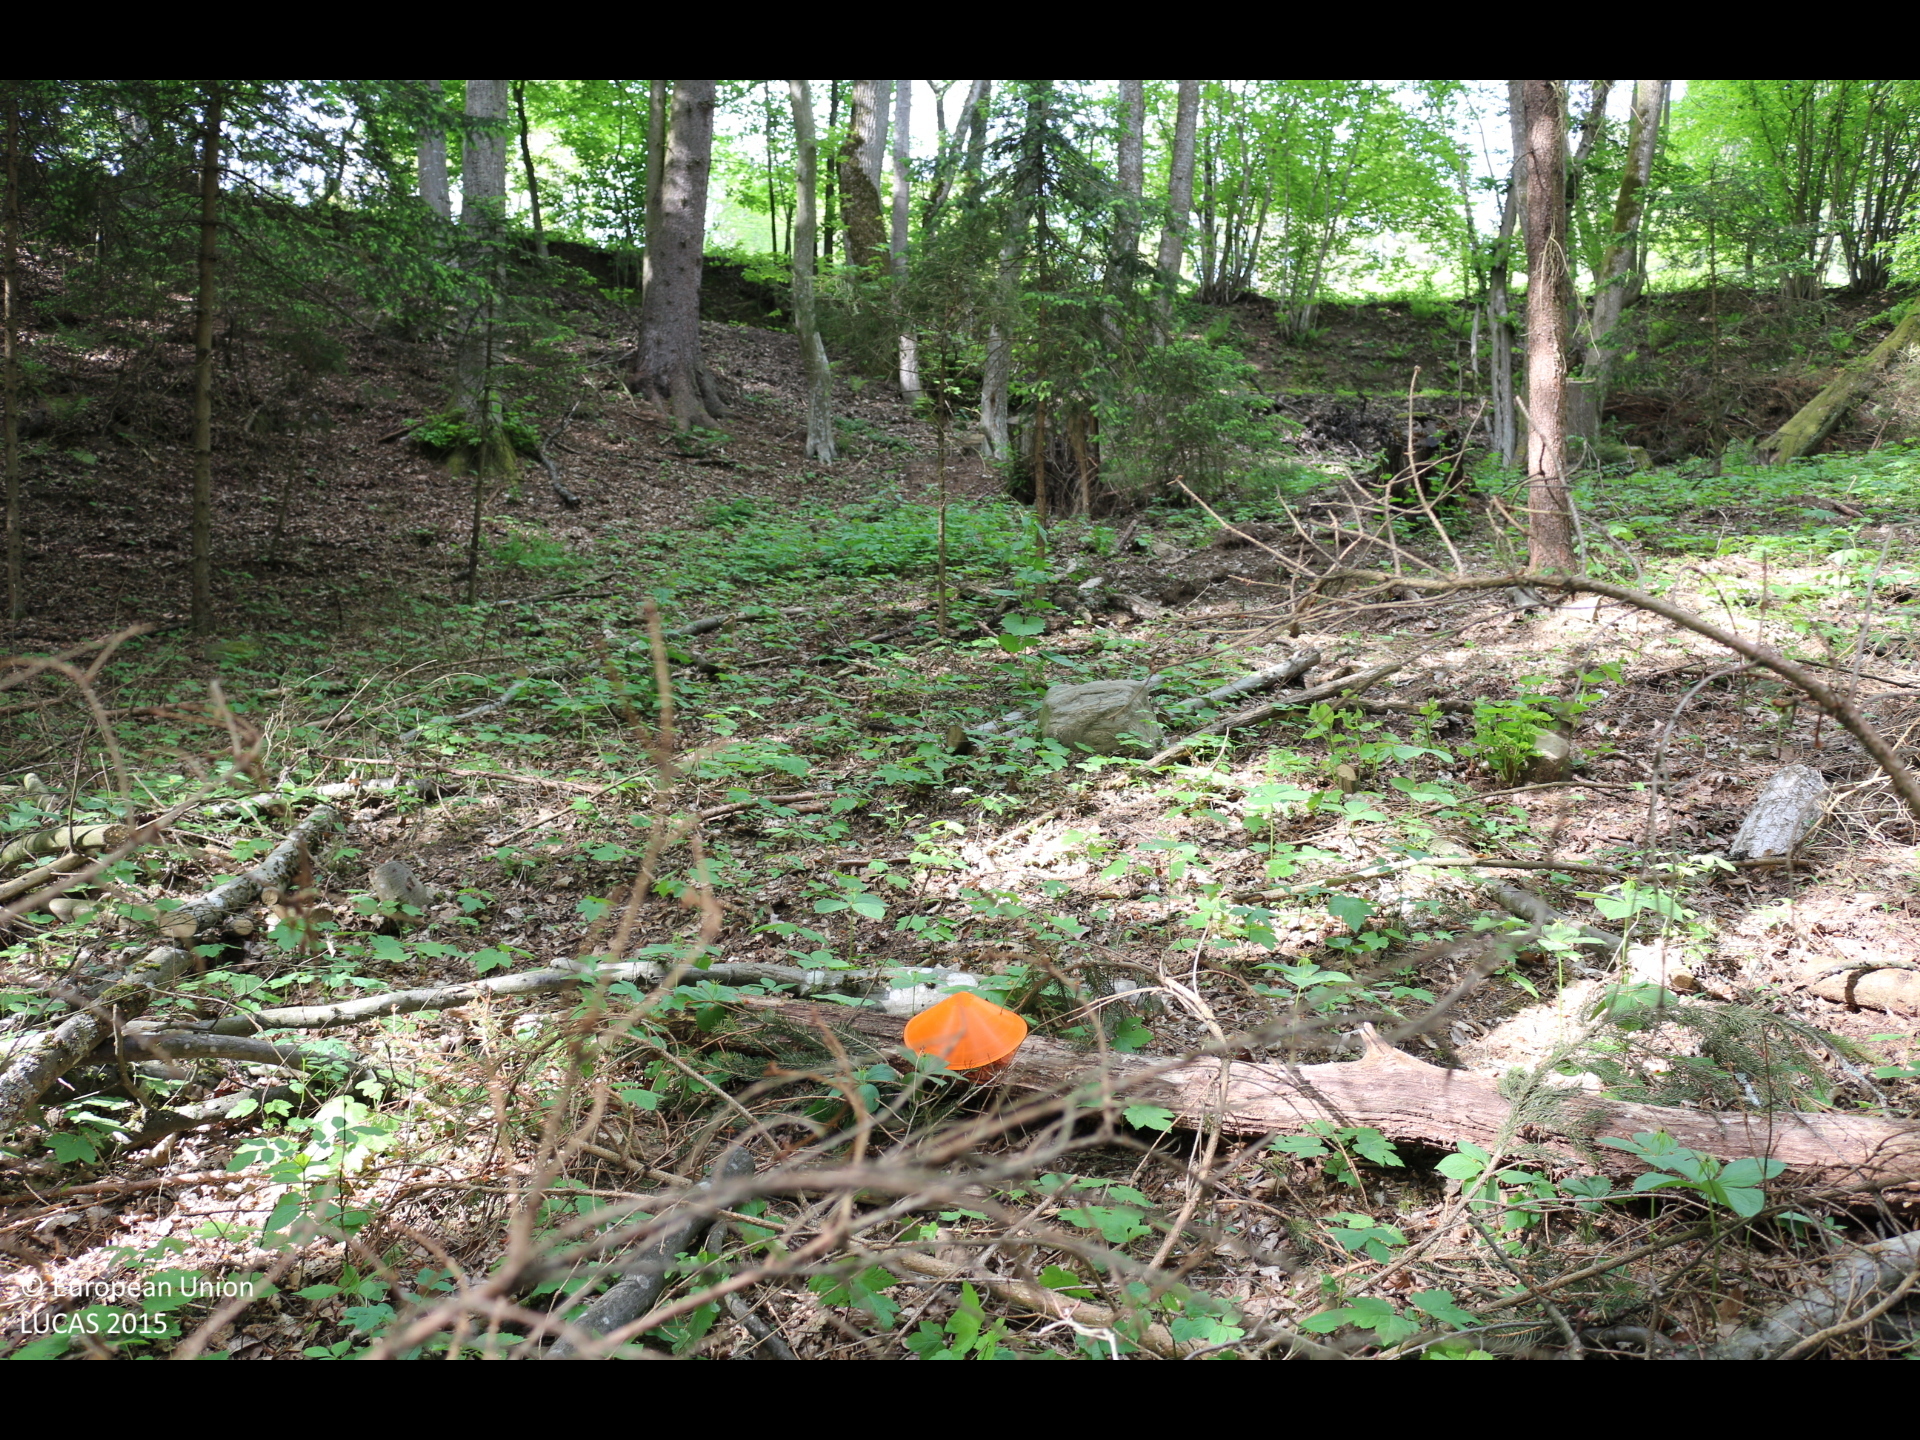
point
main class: Woodland
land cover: Spruce dominated mixed woodland
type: alpine coniferous forest
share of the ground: > 75 %
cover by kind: broadleaved forest trees 60 %, coniferous forest trees 40 %
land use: Forestry
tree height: > 5 m
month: May
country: AT
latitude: 46.6807
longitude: 14.2726
